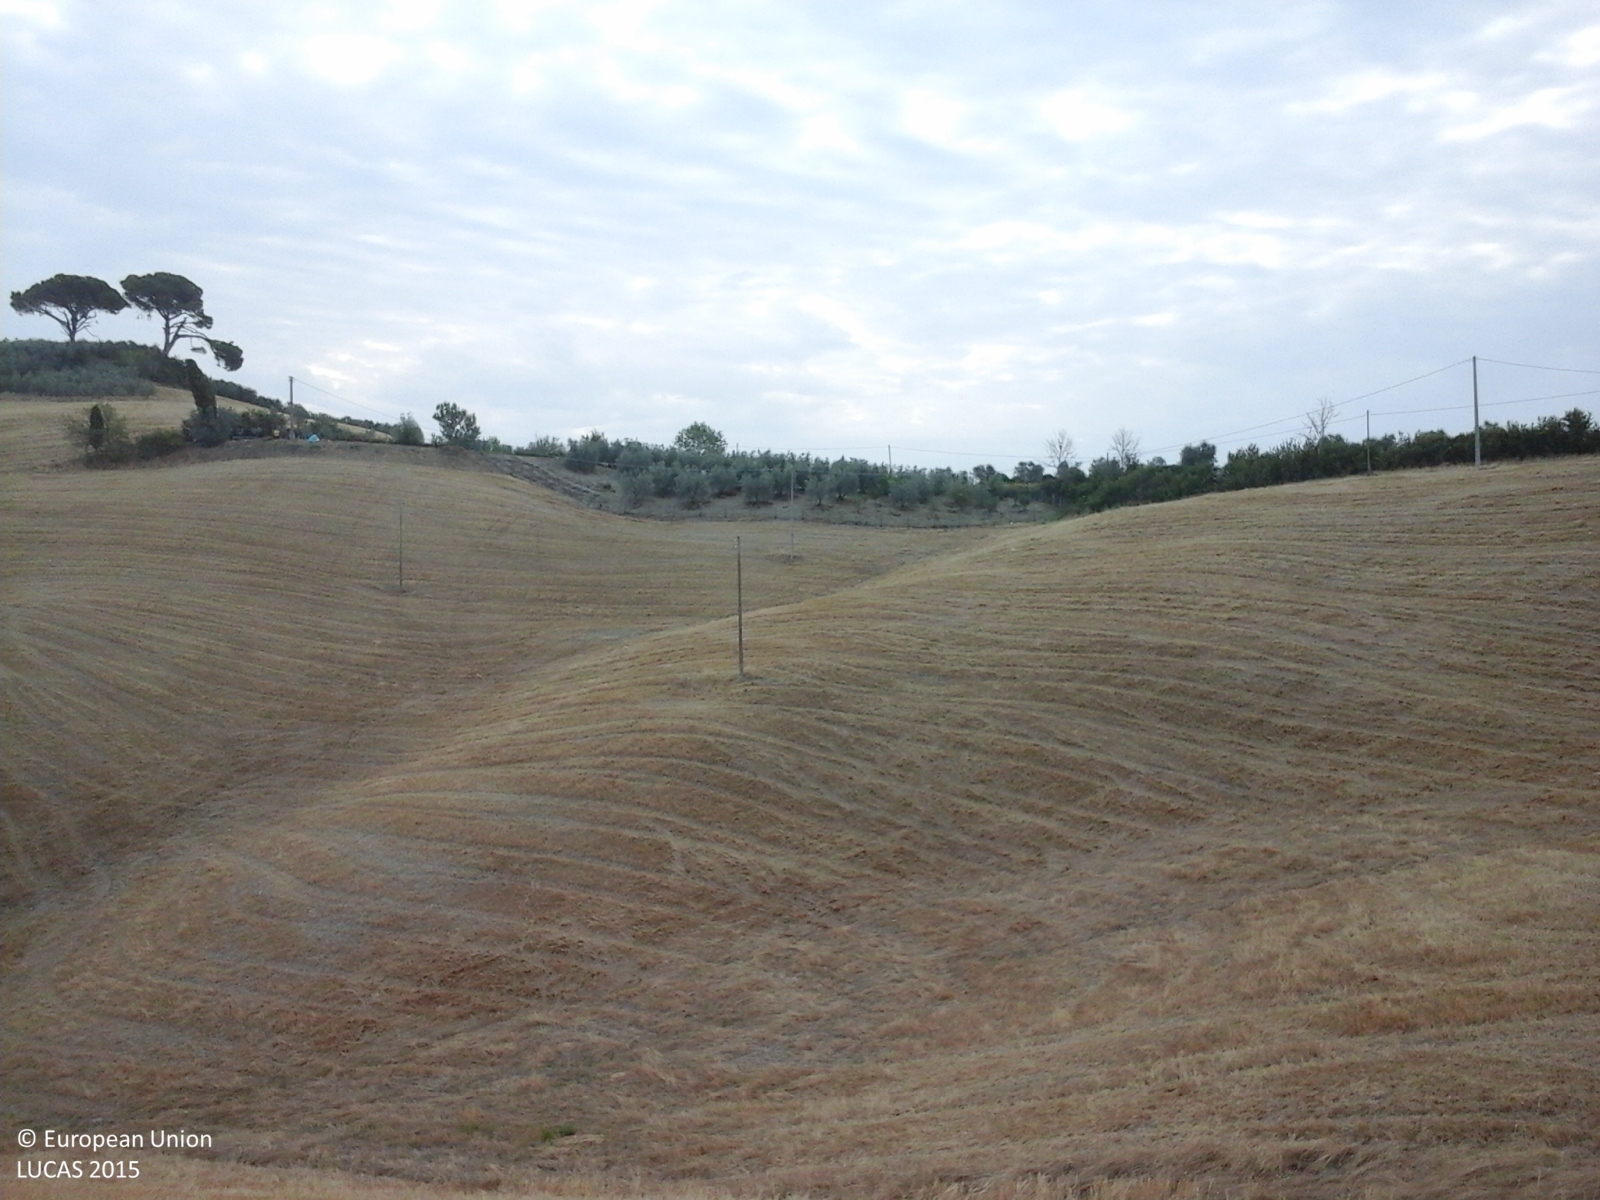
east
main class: Cropland
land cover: Durum wheat
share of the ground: > 75 %
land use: Agriculture (excluding fallow land and kitchen gardens)
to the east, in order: Durum wheat; Grass margins; Tracks; Grass margins; Fences; Olive groves; Fences; Grass margins; Tracks; Inland fresh water bodies; Managed hedges; Fences
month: July
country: IT
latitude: 43.2752
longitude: 11.4866
